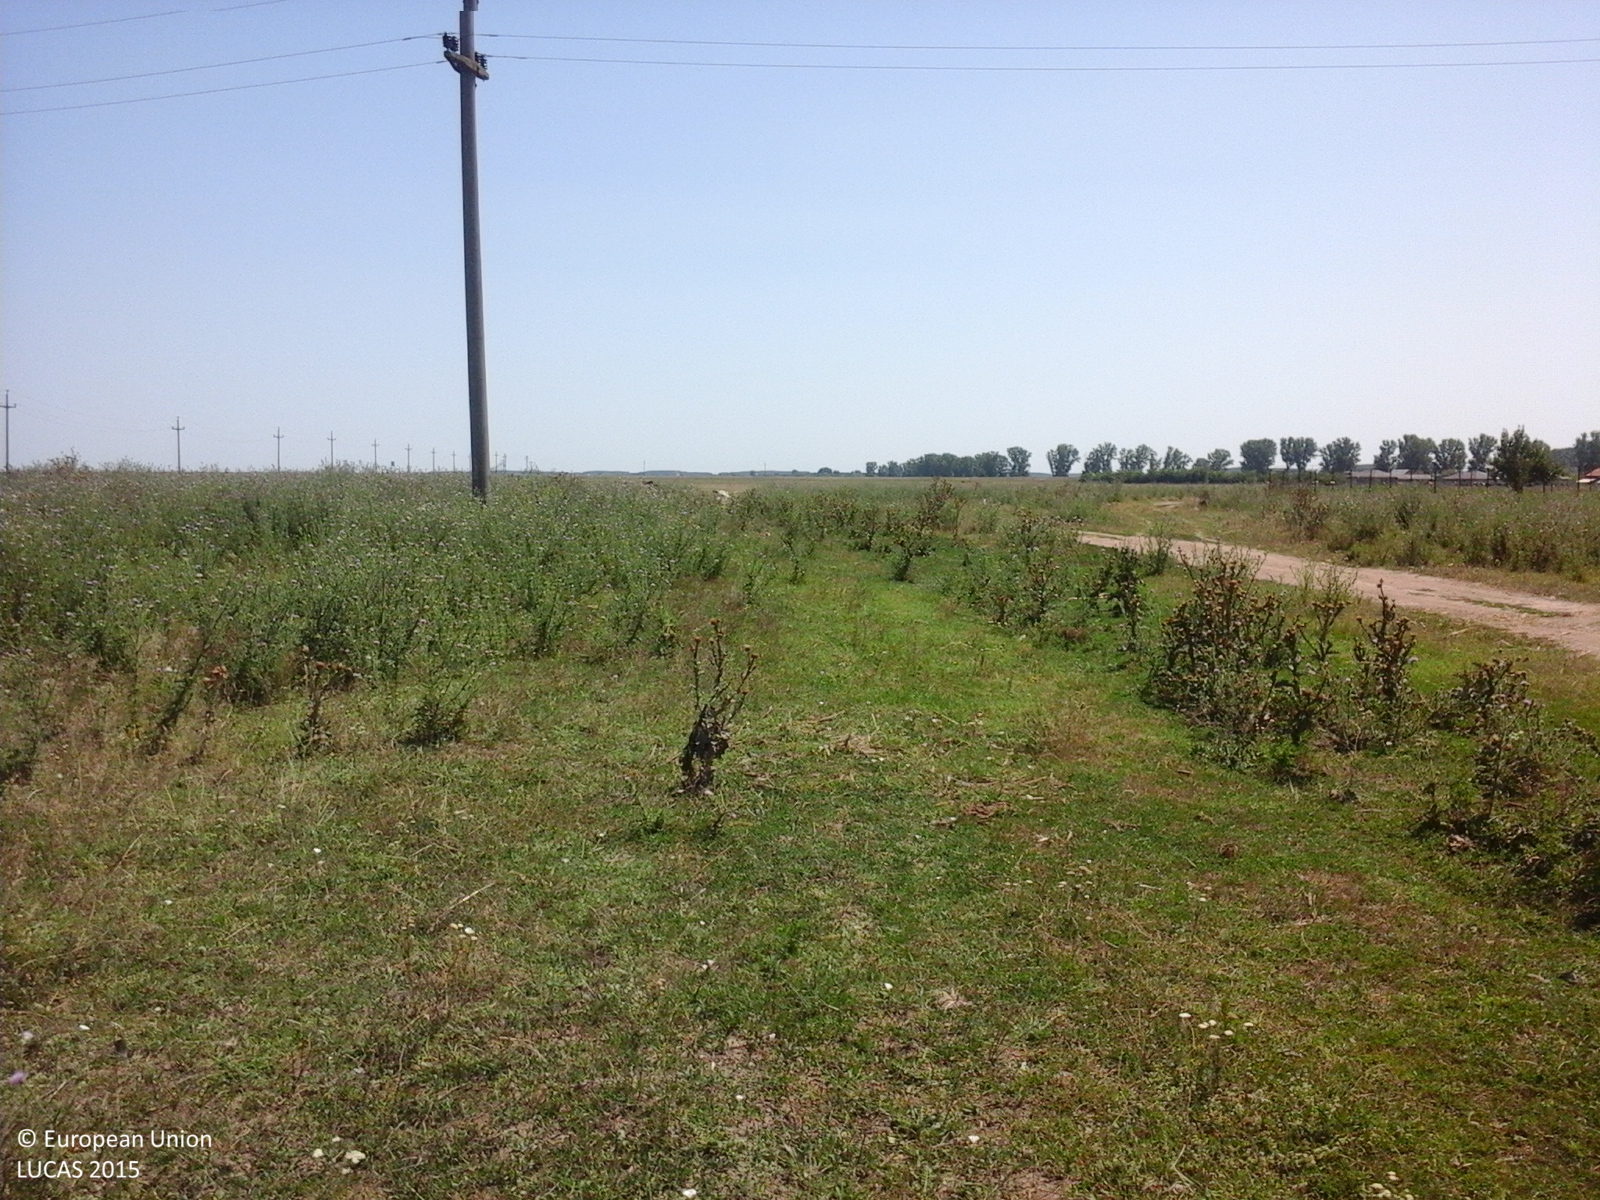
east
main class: Grassland
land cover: Grassland without tree/shrub cover
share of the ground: > 75 %
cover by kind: herbaceous plants 100 %
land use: Agriculture (excluding fallow land and kitchen gardens)
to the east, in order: Grassland without tree/shrub cover; Electric lines; Grassland without tree/shrub cover; Tracks; Grassland without tree/shrub cover
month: July
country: RO
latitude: 44.2301
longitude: 27.5043
